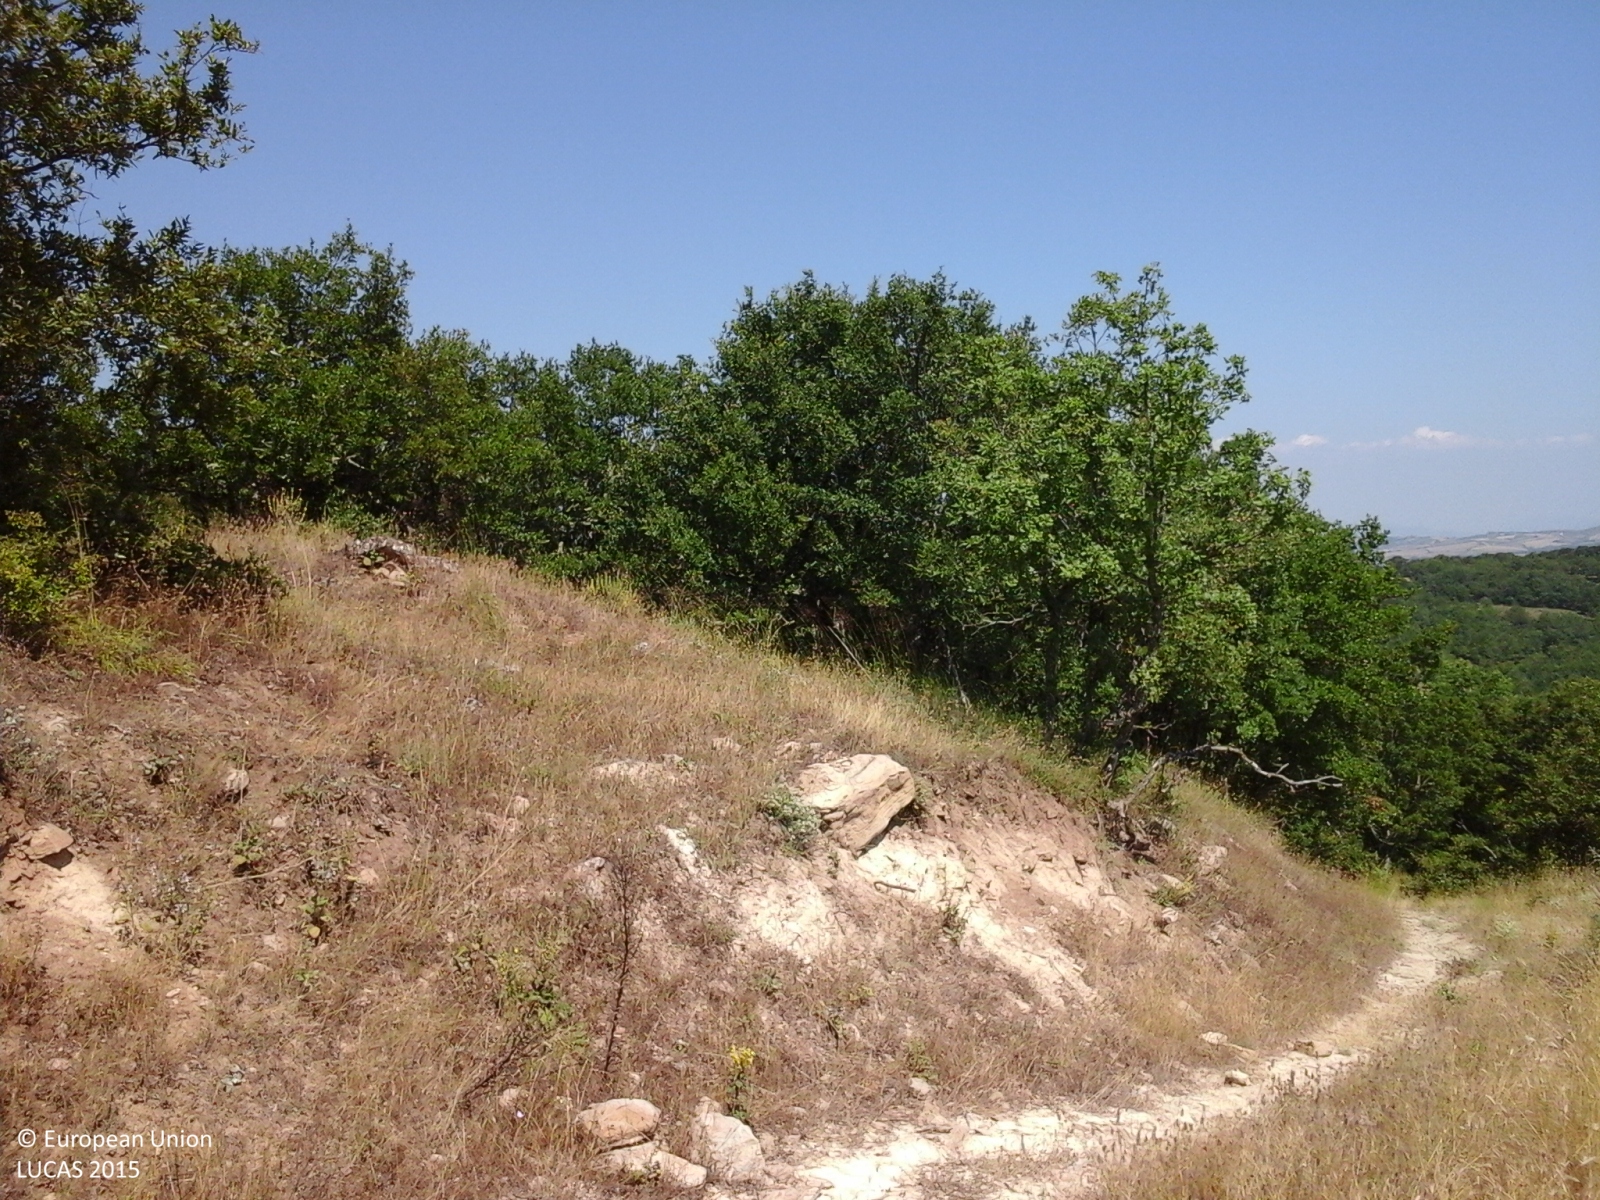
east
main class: Cropland
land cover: Vineyards
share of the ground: 50 - 75 %
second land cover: Spontaneously vegetated surfaces
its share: > 75 %
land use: Agriculture (excluding fallow land and kitchen gardens)
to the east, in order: Vineyards; Spontaneously vegetated surfaces; Fences; Broadleaved woodland
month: July
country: GR
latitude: 40.2321
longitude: 21.3056
